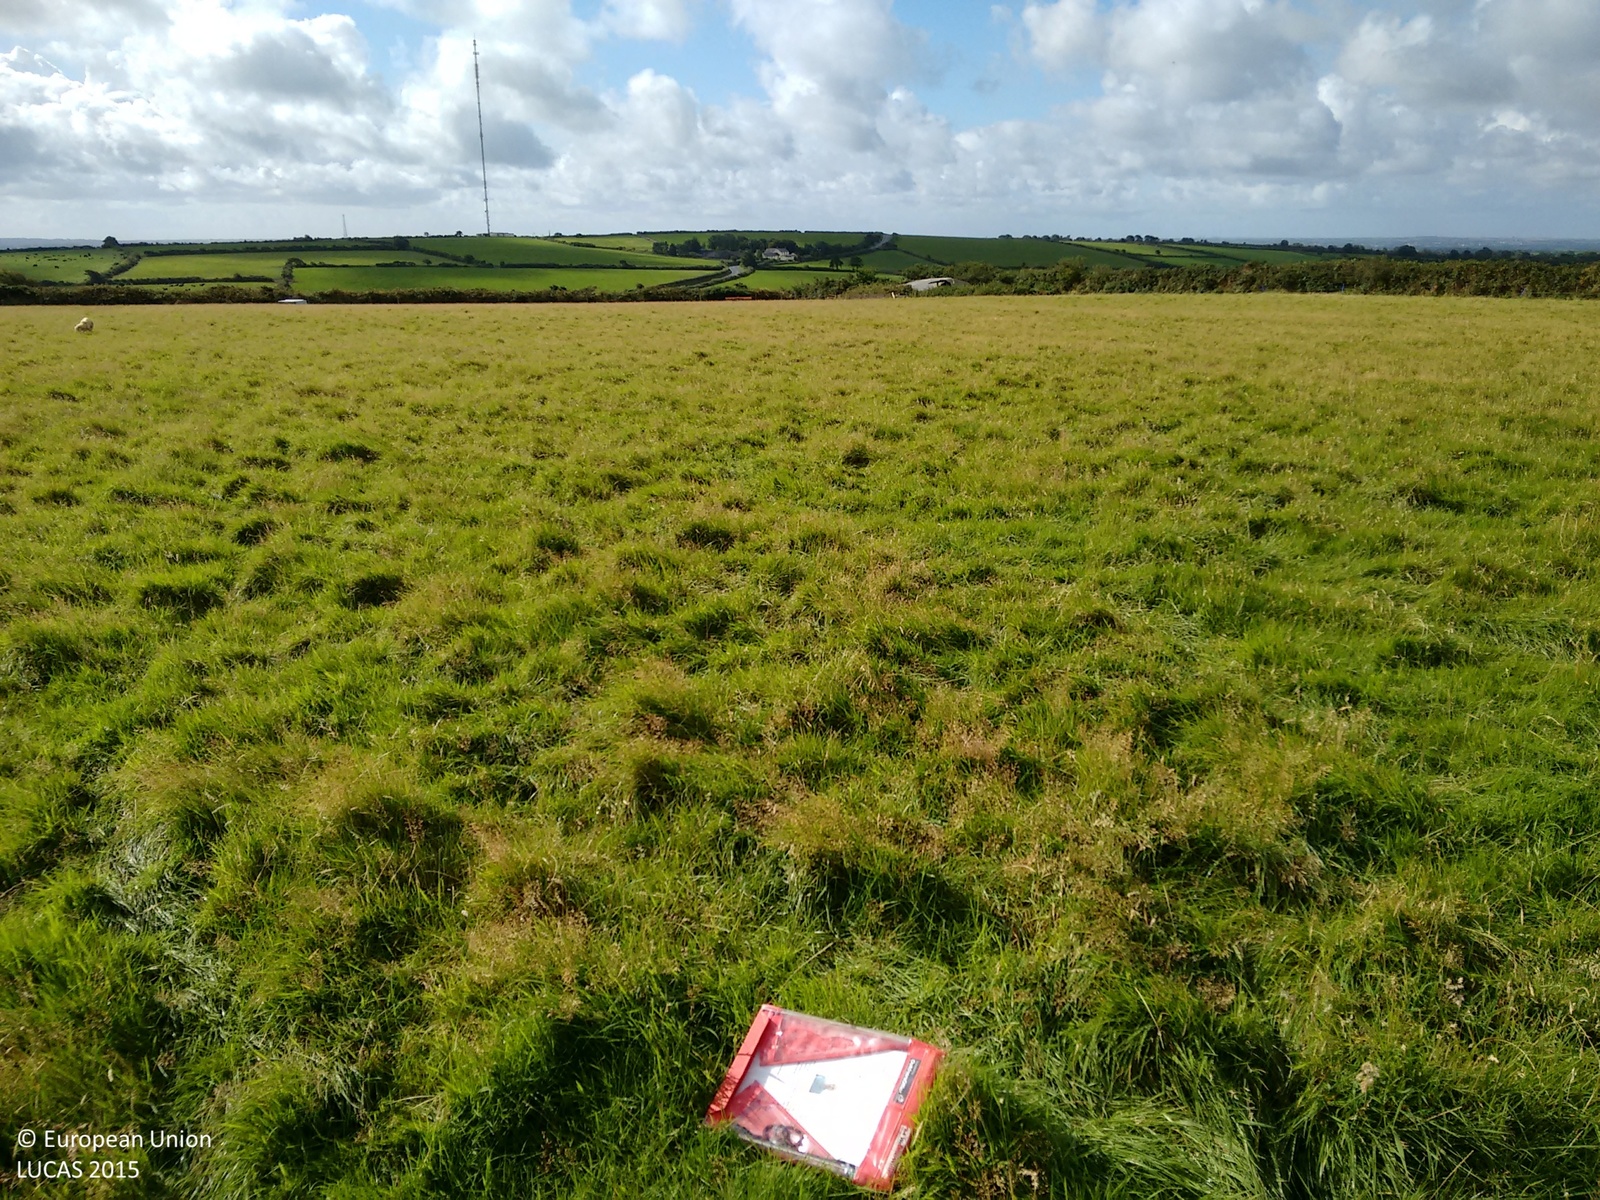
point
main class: Grassland
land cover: Grassland without tree/shrub cover
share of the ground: > 75 %
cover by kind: herbaceous plants 100 %
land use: Agriculture (excluding fallow land and kitchen gardens)
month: August
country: GB
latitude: 51.9095
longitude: -4.8685
